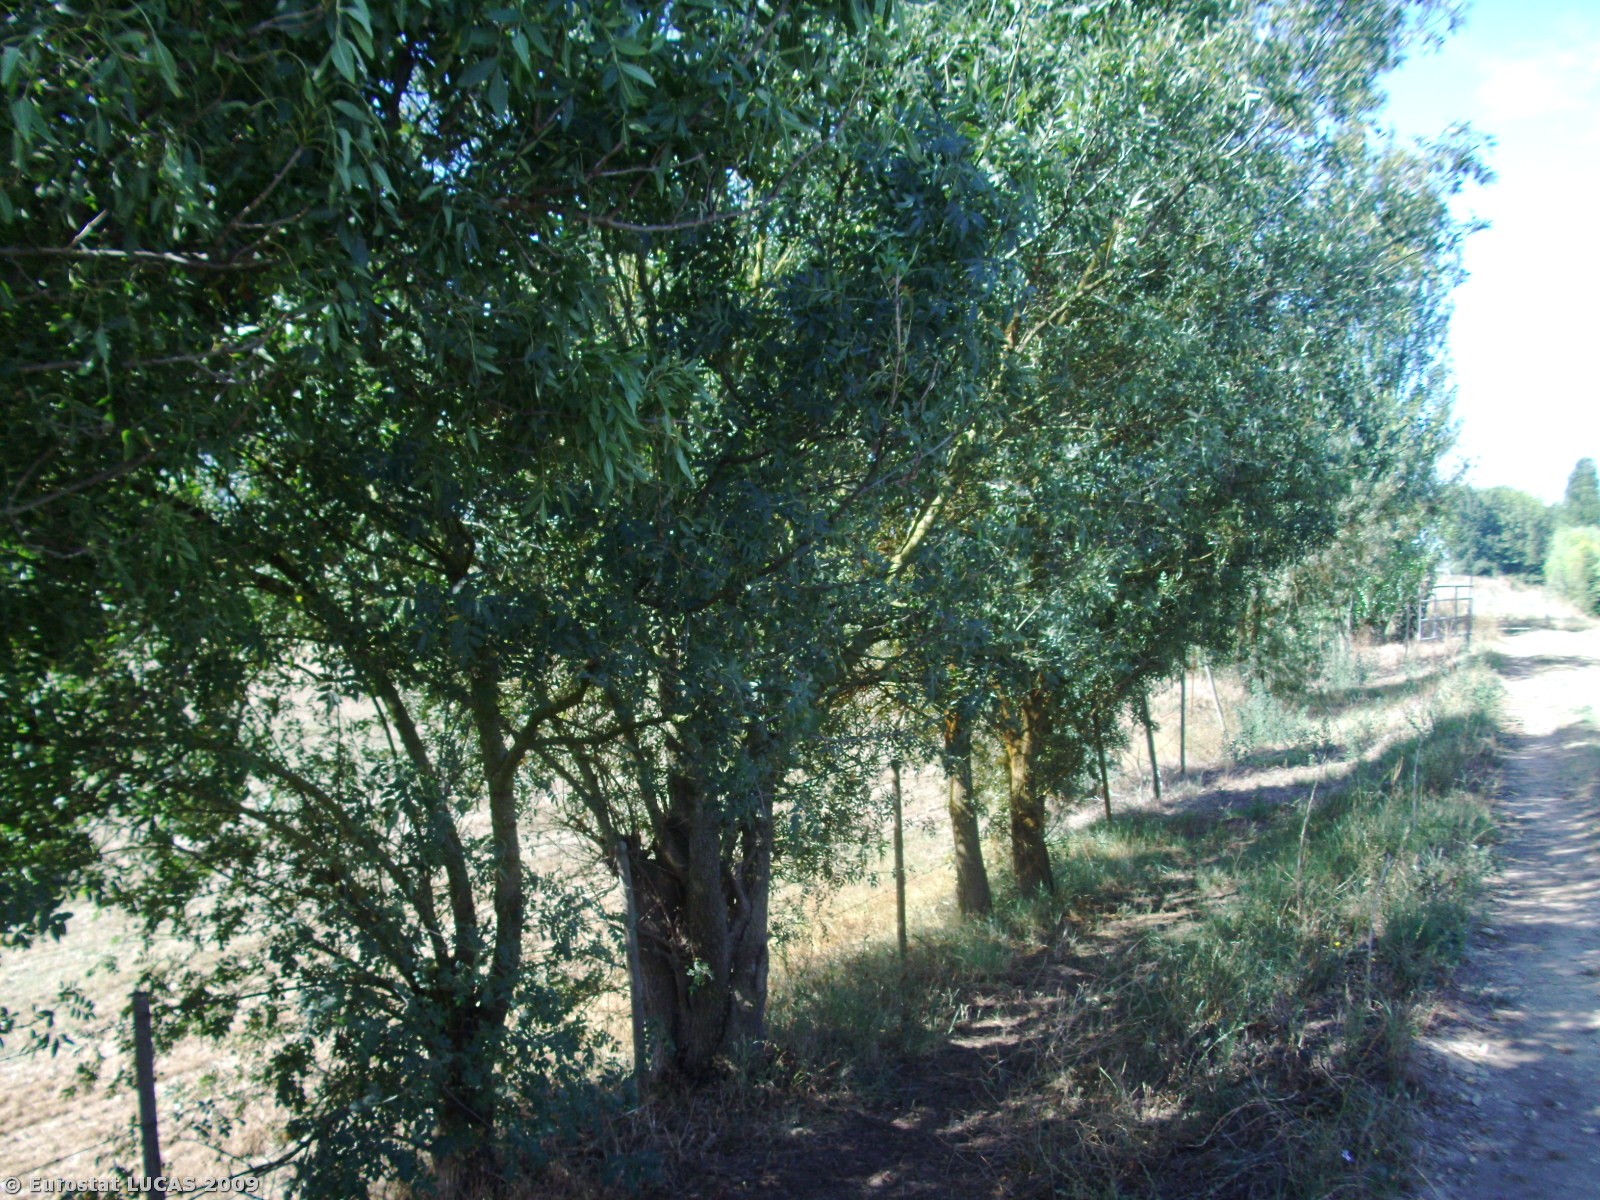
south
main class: Grassland
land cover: Grassland with sparse tree/shrub cover
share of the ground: 50 - 75 %
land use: Agriculture (excluding fallow land and kitchen gardens)
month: August
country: PT
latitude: 39.0423
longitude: -8.8004
